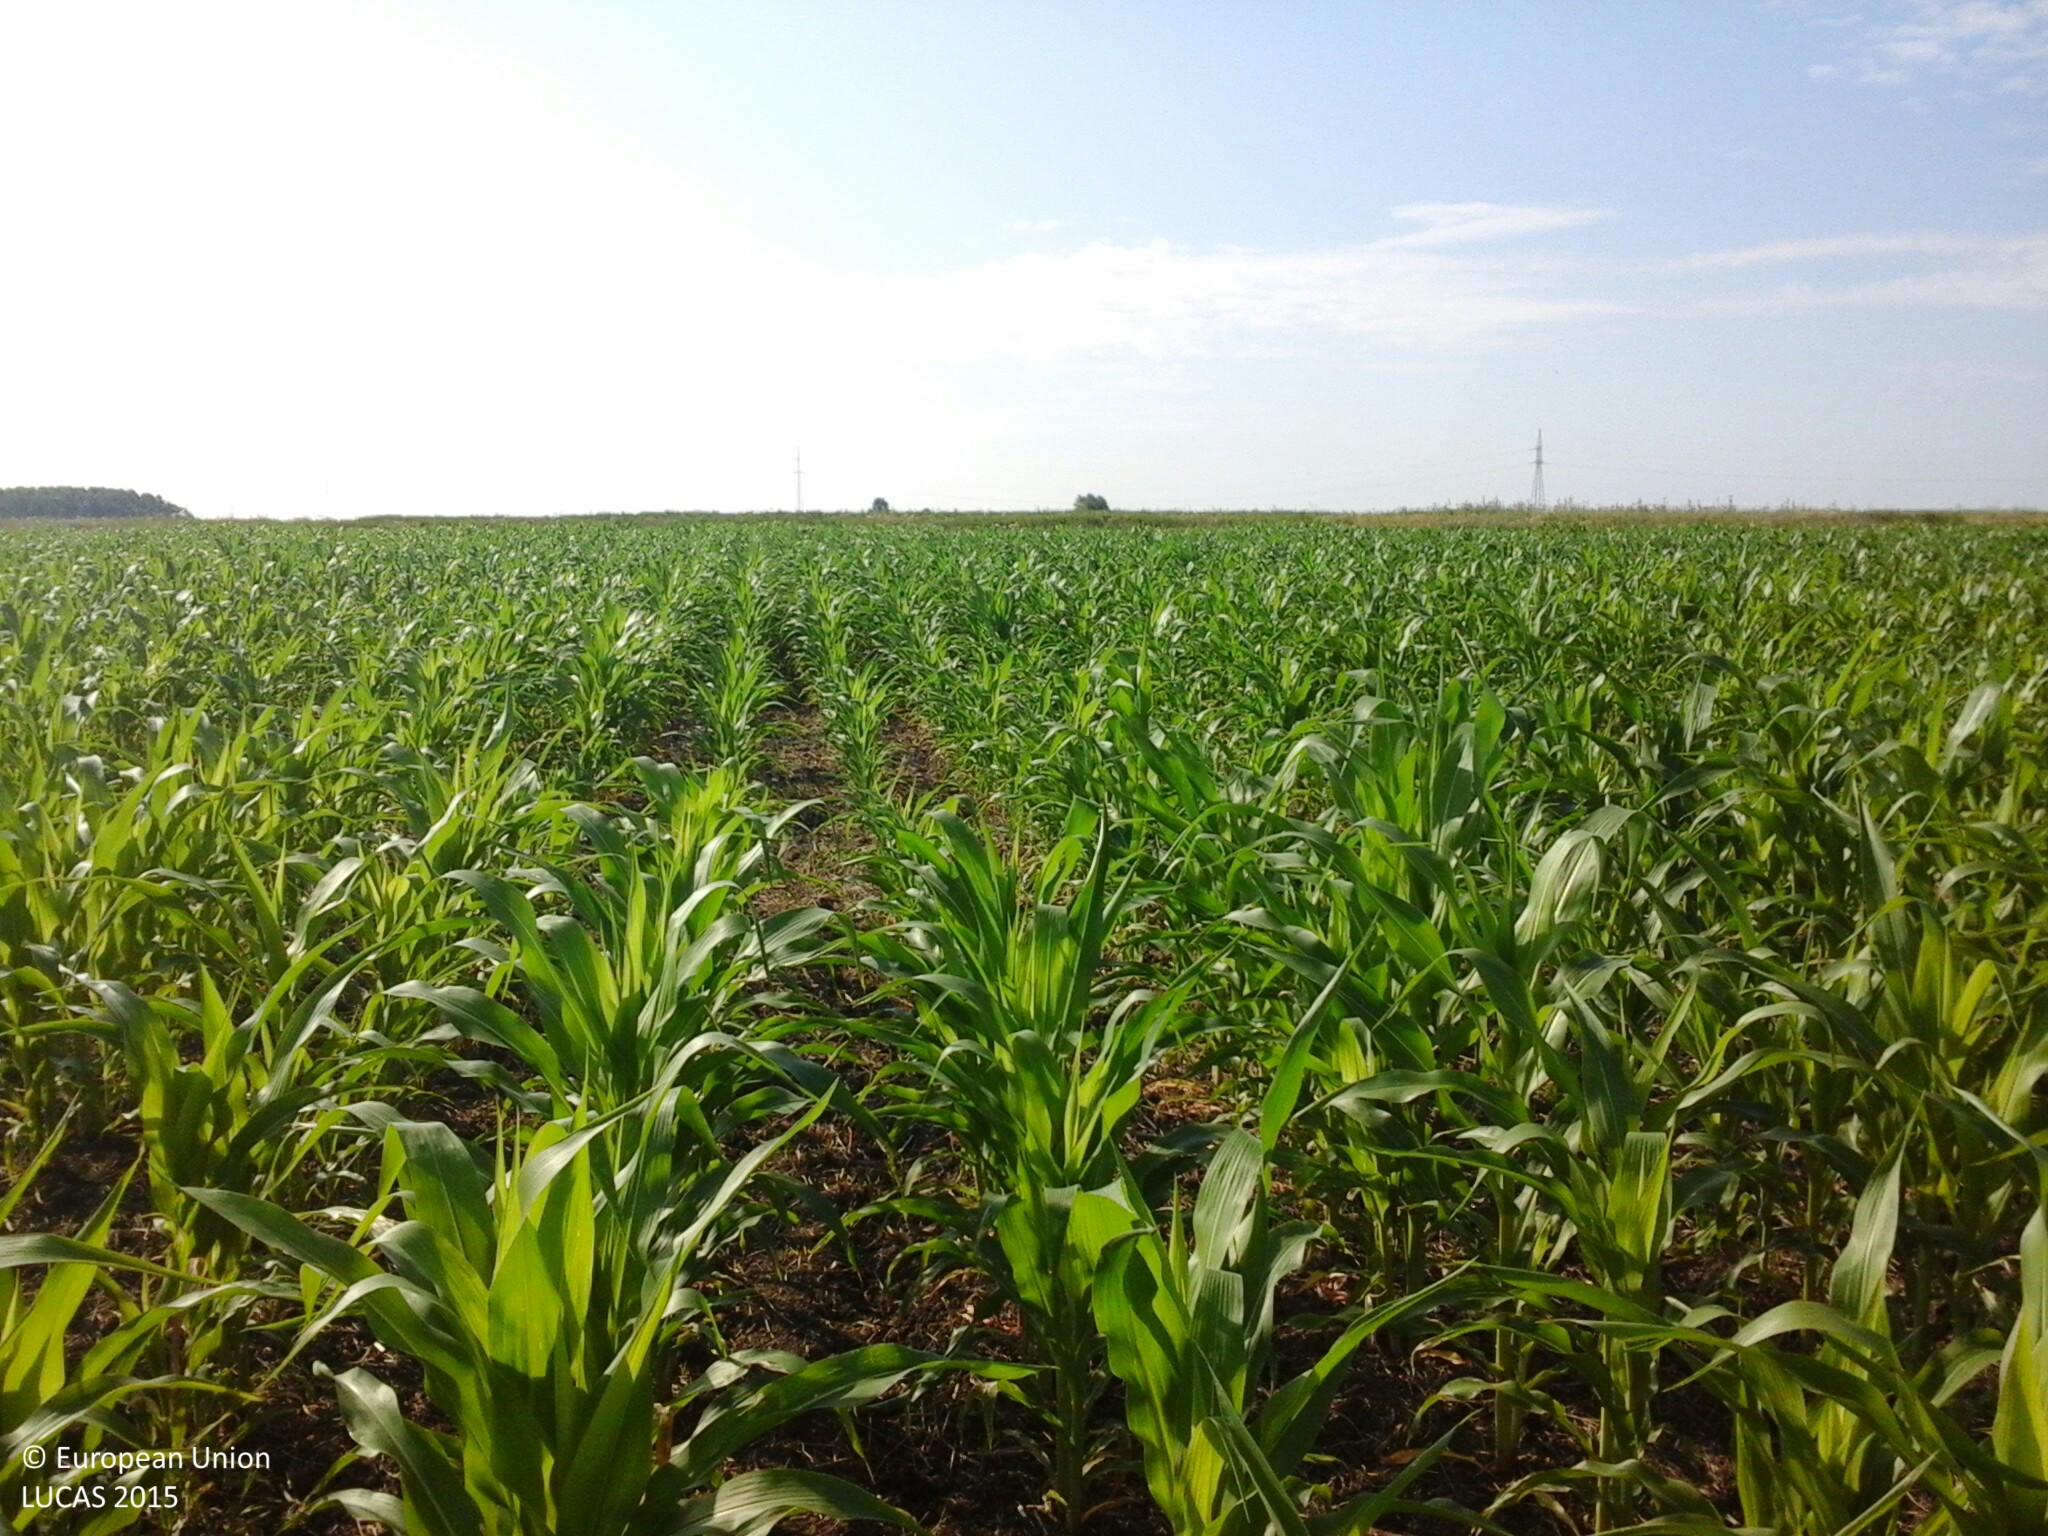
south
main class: Cropland
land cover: Maize
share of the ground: 50 - 75 %
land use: Agriculture (excluding fallow land and kitchen gardens)
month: July
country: HU
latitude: 48.0142
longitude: 22.3781
